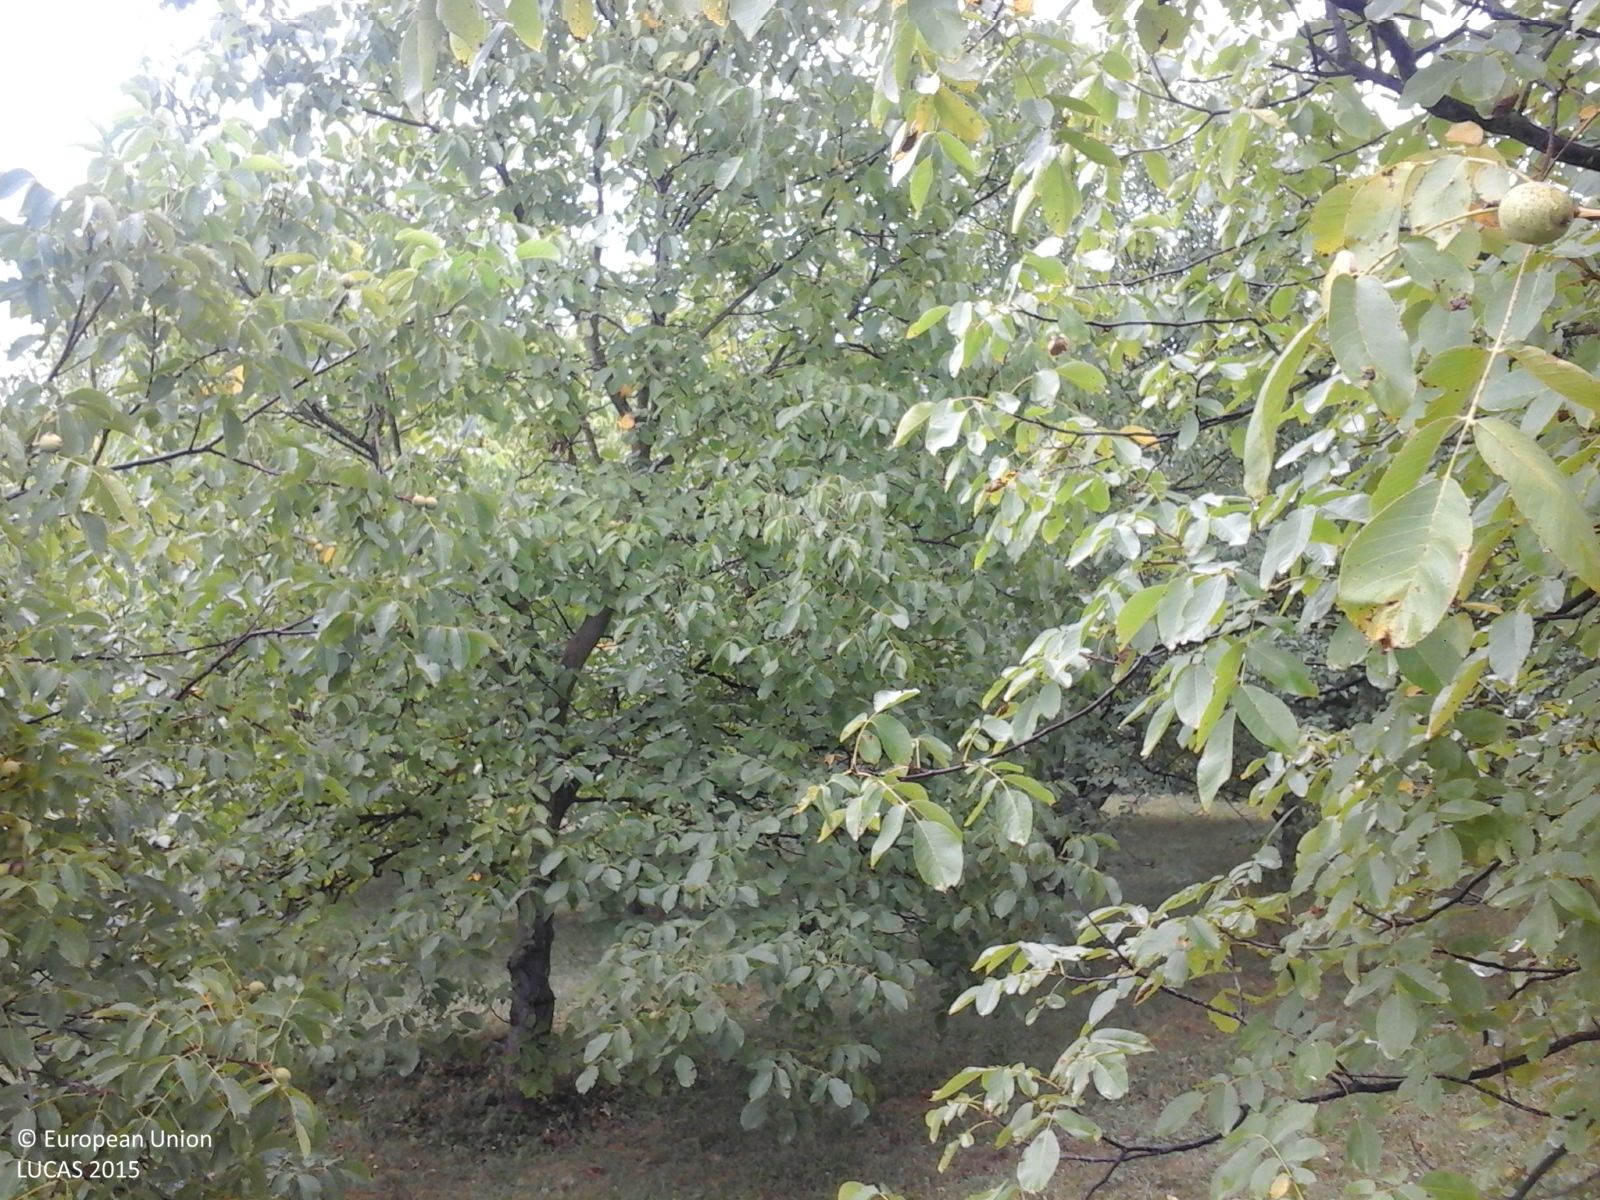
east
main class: Cropland
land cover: Nuts trees
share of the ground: 50 - 75 %
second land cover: Grassland without tree/shrub cover
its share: > 75 %
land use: Agriculture (excluding fallow land and kitchen gardens)
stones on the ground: < 10 %
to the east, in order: Nuts trees; Grassland without tree/shrub cover; Fences; Abandoned hedges; Grassland without tree/shrub cover; Lines of trees; Grassland without tree/shrub cover; Other fruit trees and berries; Grassland without tree/shrub cover; Shruby margins; Grassland without tree/shrub cover; Artificial constructions in urban areas
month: September
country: RO
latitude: 47.9275
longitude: 23.8550
